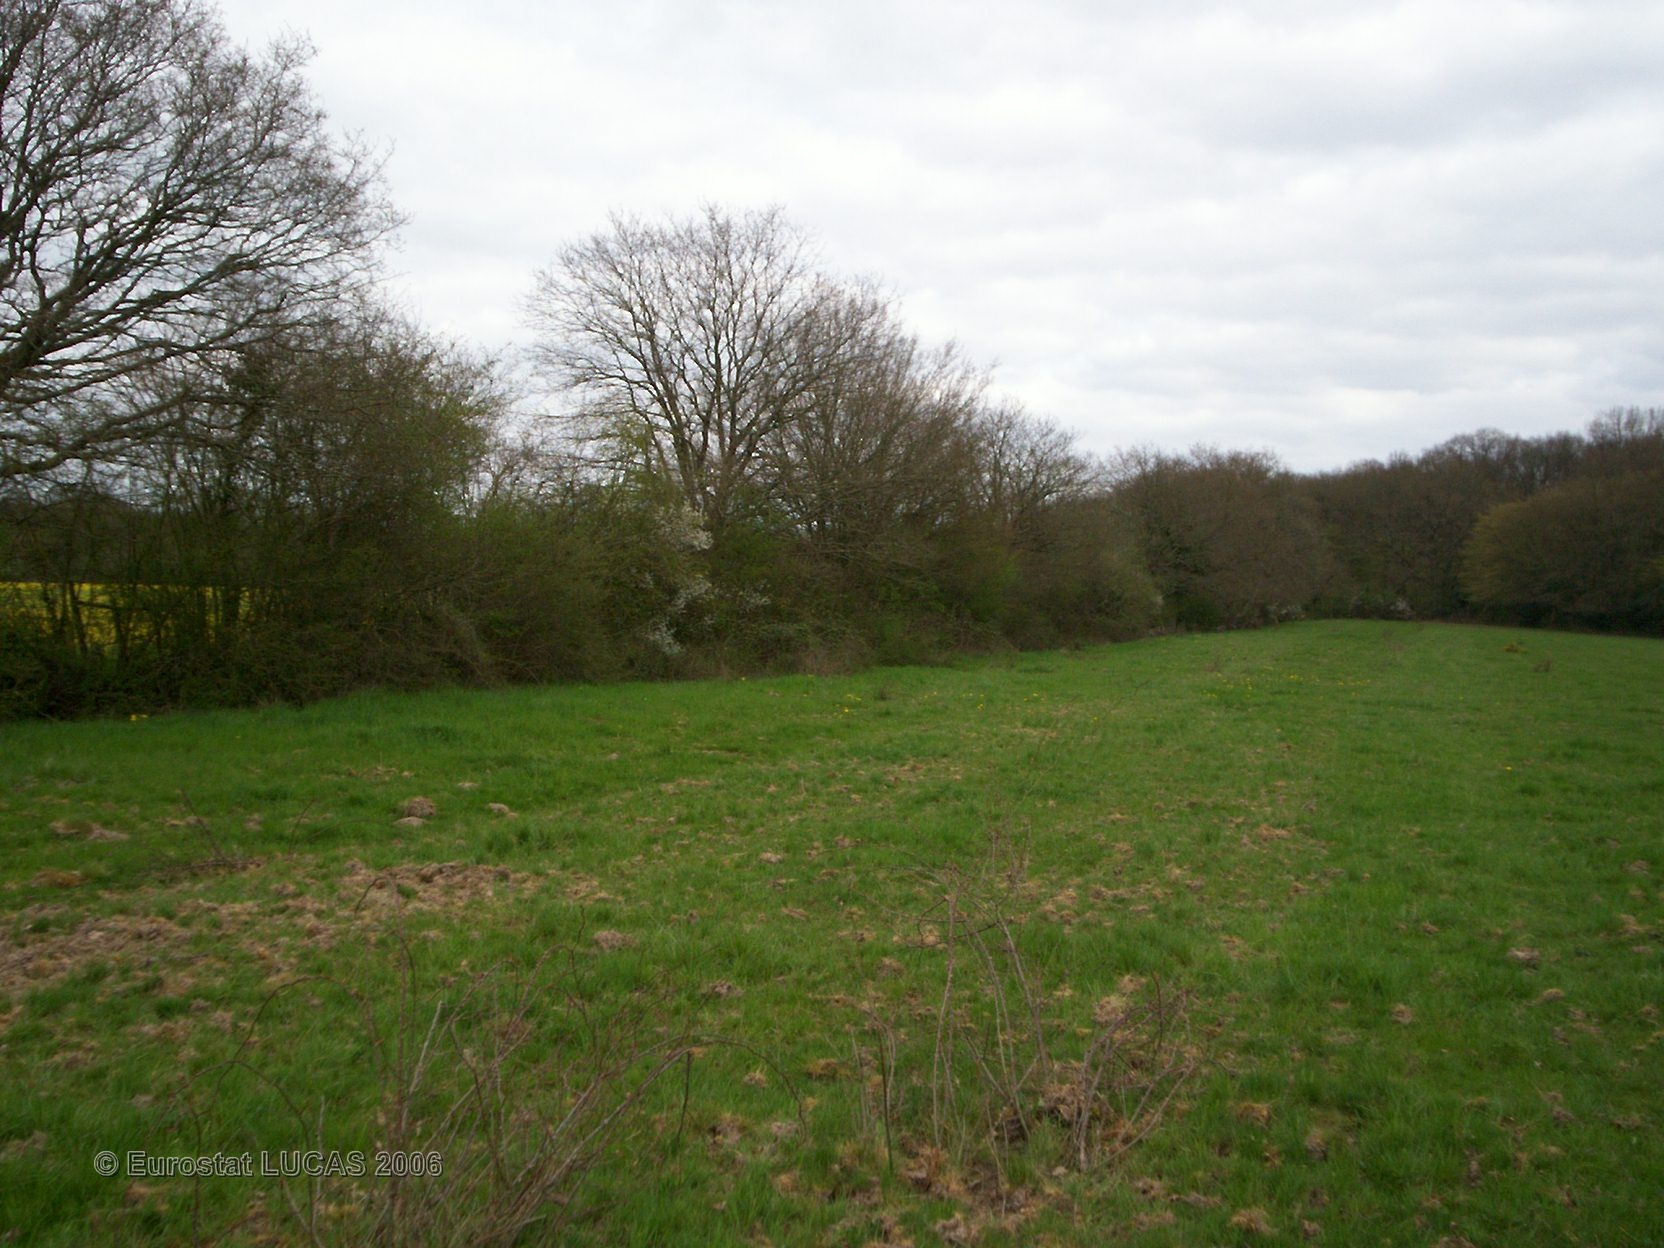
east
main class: Grassland
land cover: Grassland without tree/shrub cover
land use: Agriculture (excluding fallow land and kitchen gardens)
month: April
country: FR
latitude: 47.5617
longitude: 0.1265
